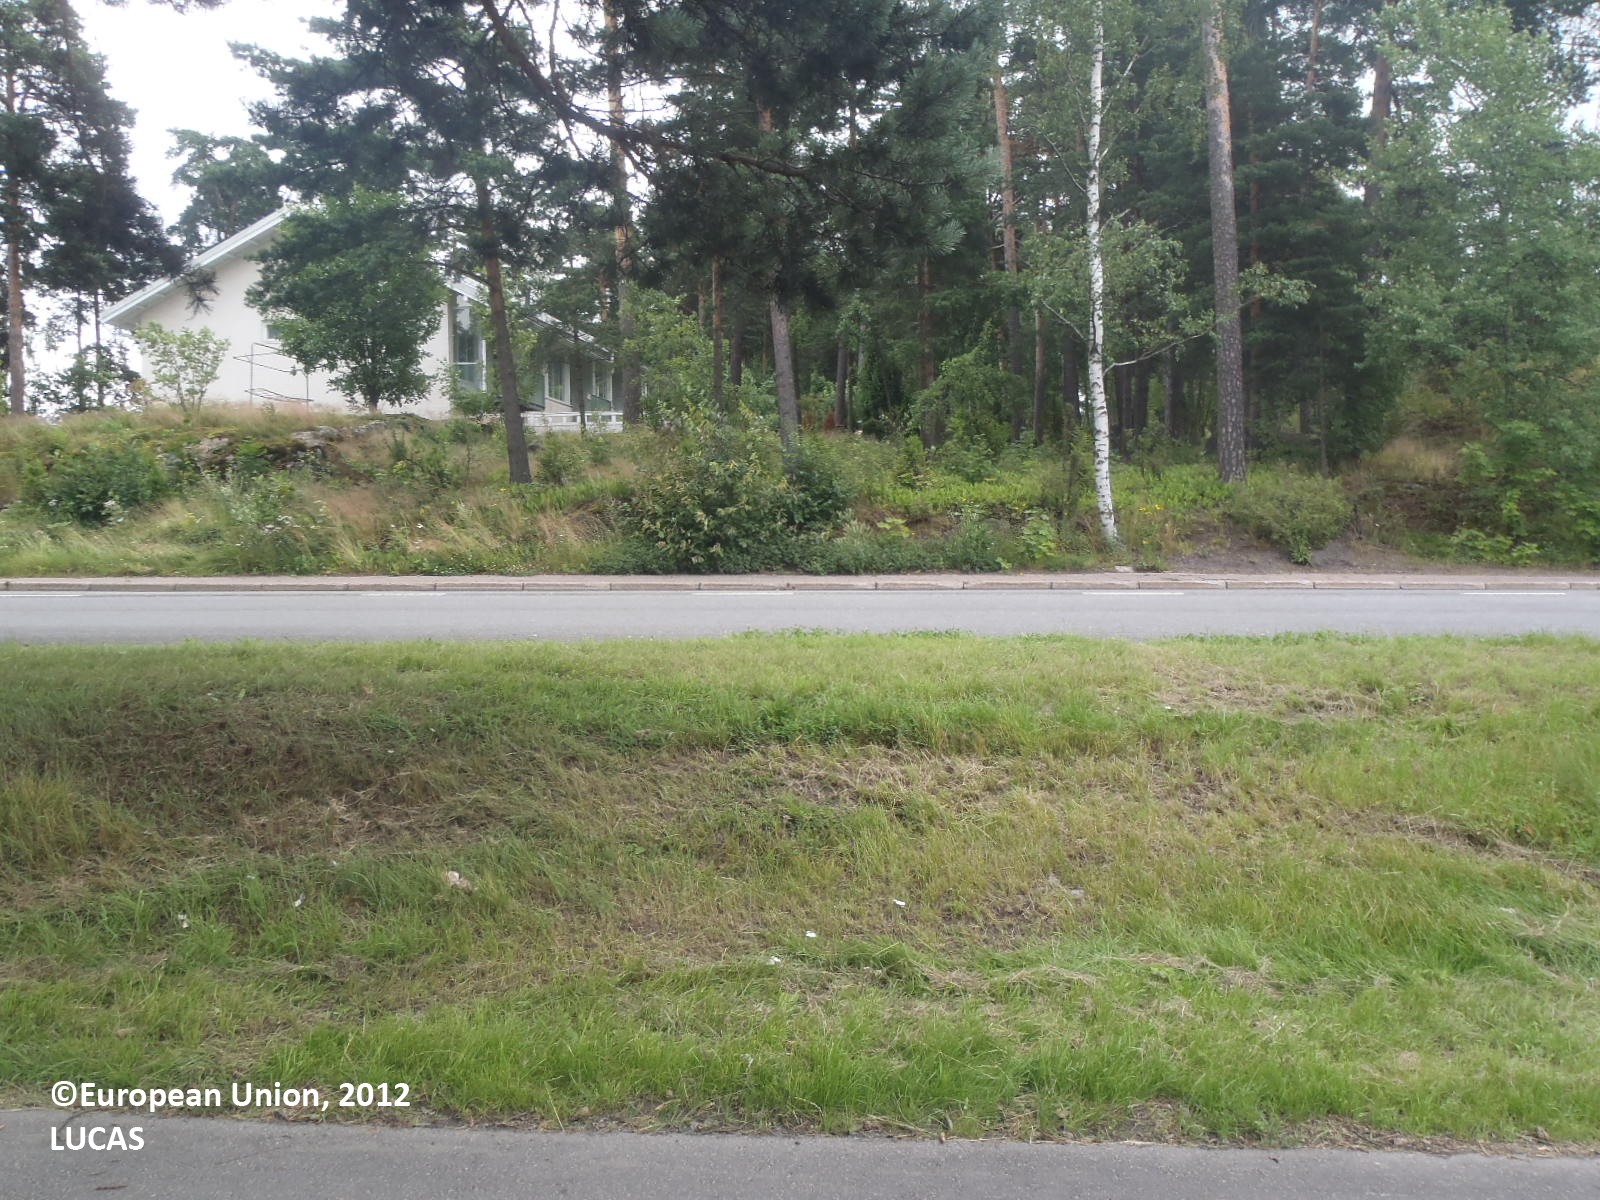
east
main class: Grassland
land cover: Grassland with sparse tree/shrub cover
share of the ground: > 75 %
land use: Residential
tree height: > 5 m
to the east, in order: Grassland without tree/shrub cover; Artificial constructions in urban areas
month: July
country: FI
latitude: 60.4671
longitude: 22.2337
